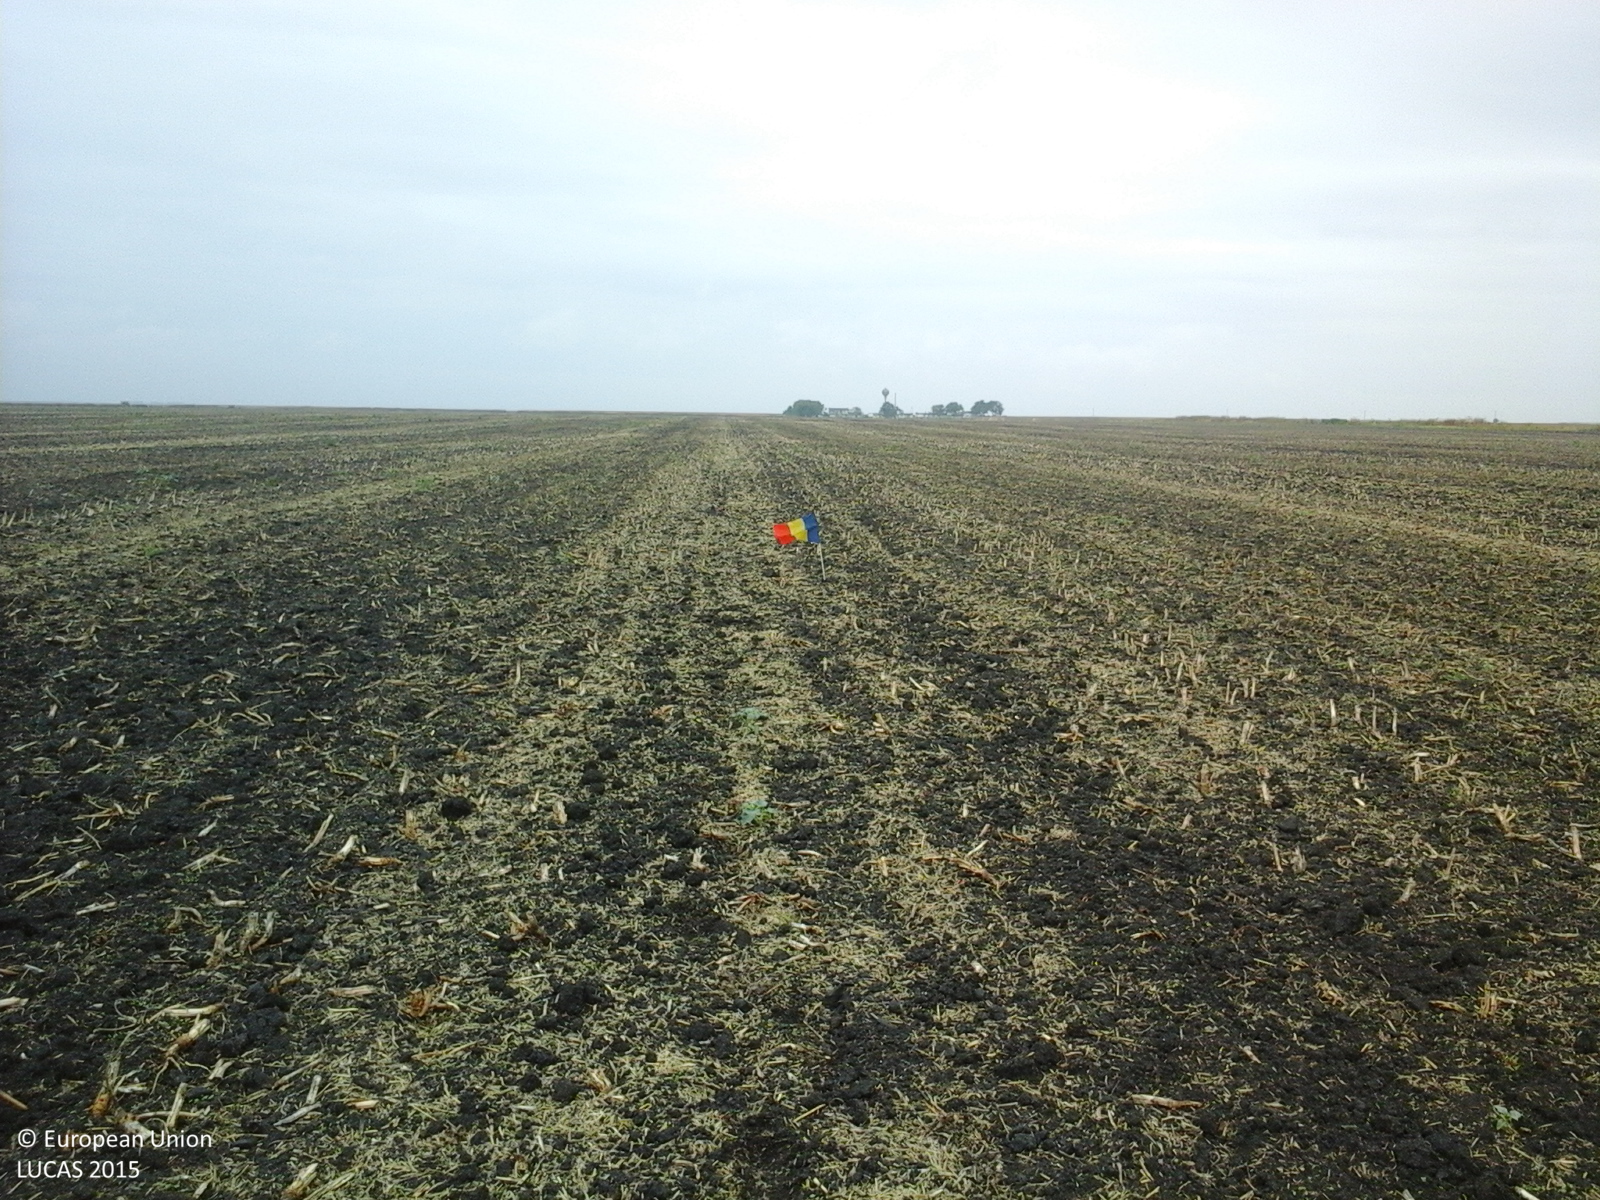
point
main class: Cropland
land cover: Rape and turnip rape
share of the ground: < 10 %
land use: Agriculture (excluding fallow land and kitchen gardens)
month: August
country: RO
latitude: 45.8492
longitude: 20.7008
